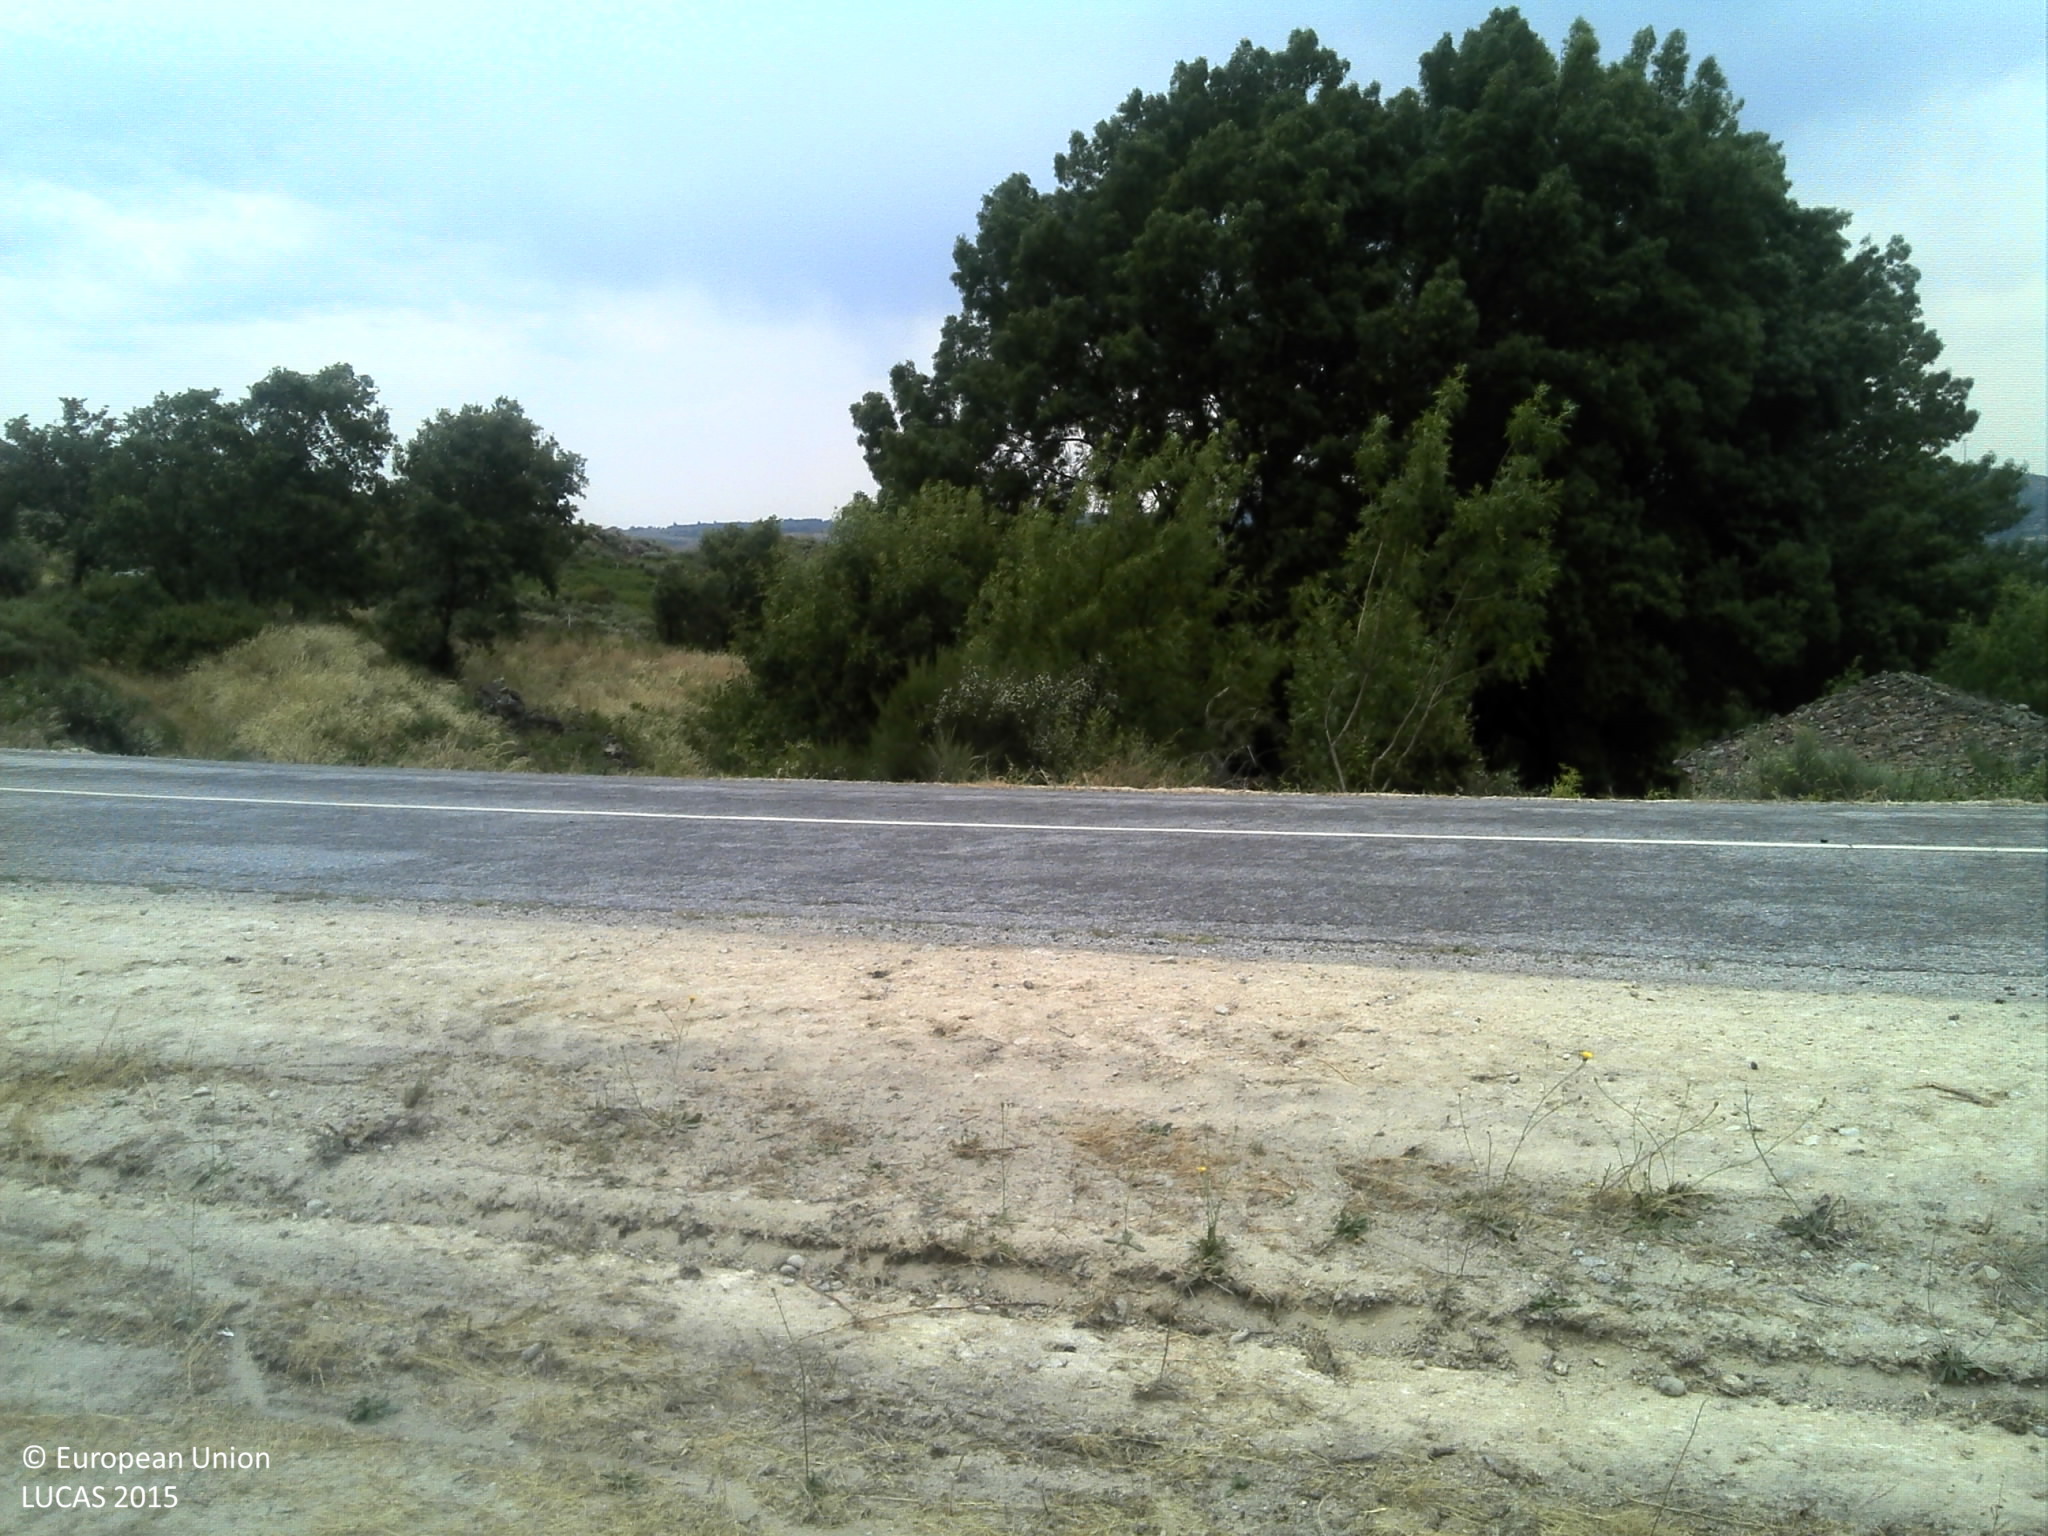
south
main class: Shrubland
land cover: Shrubland without tree cover
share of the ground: 25 - 50 %
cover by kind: shrubs 45 %, unconsolidated bare surface 25 %, herbaceous plants 5 %
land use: Semi-natural and natural areas not in use
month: June
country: PT
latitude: 40.3433
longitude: -7.1823
